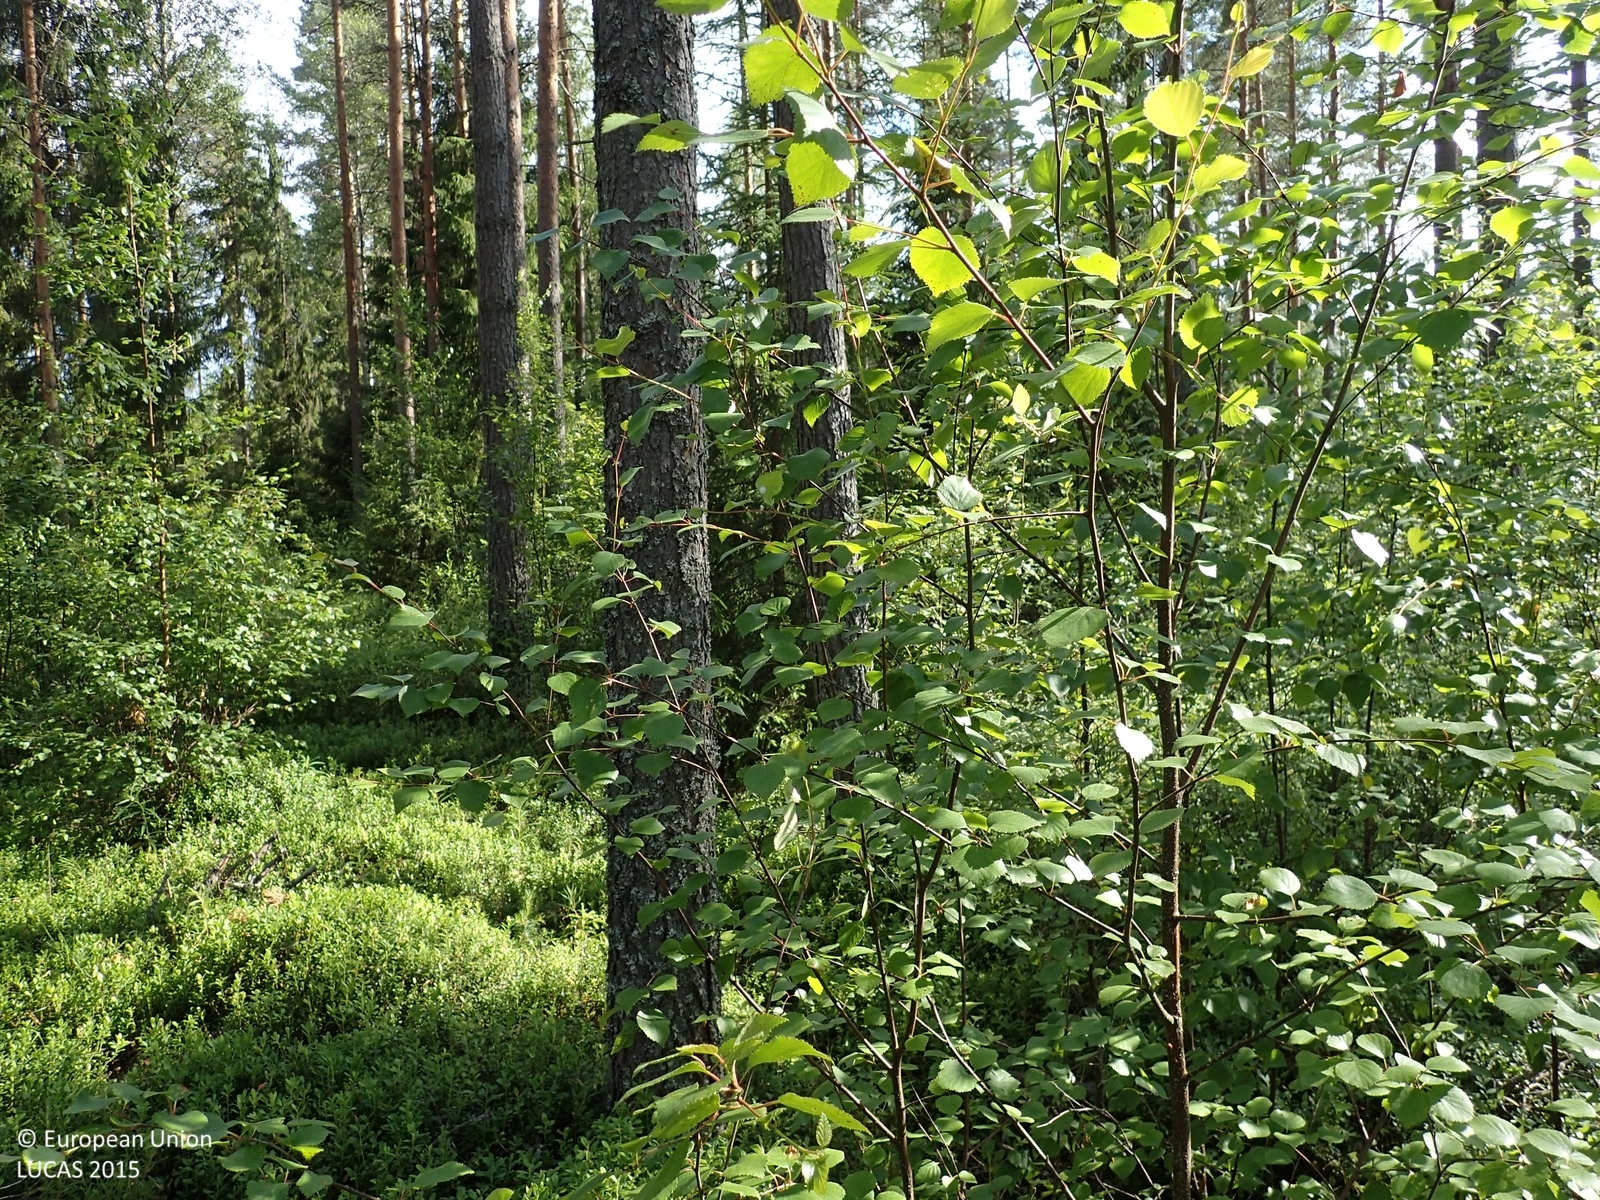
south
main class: Woodland
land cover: Pine dominated mixed woodland
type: boreal forest
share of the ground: 25 - 50 %
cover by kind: shrubs 60 %, coniferous forest trees 30 %, broadleaved forest trees 10 %
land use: Forestry
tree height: > 5 m
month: July
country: FI
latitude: 62.8281
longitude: 23.2744
